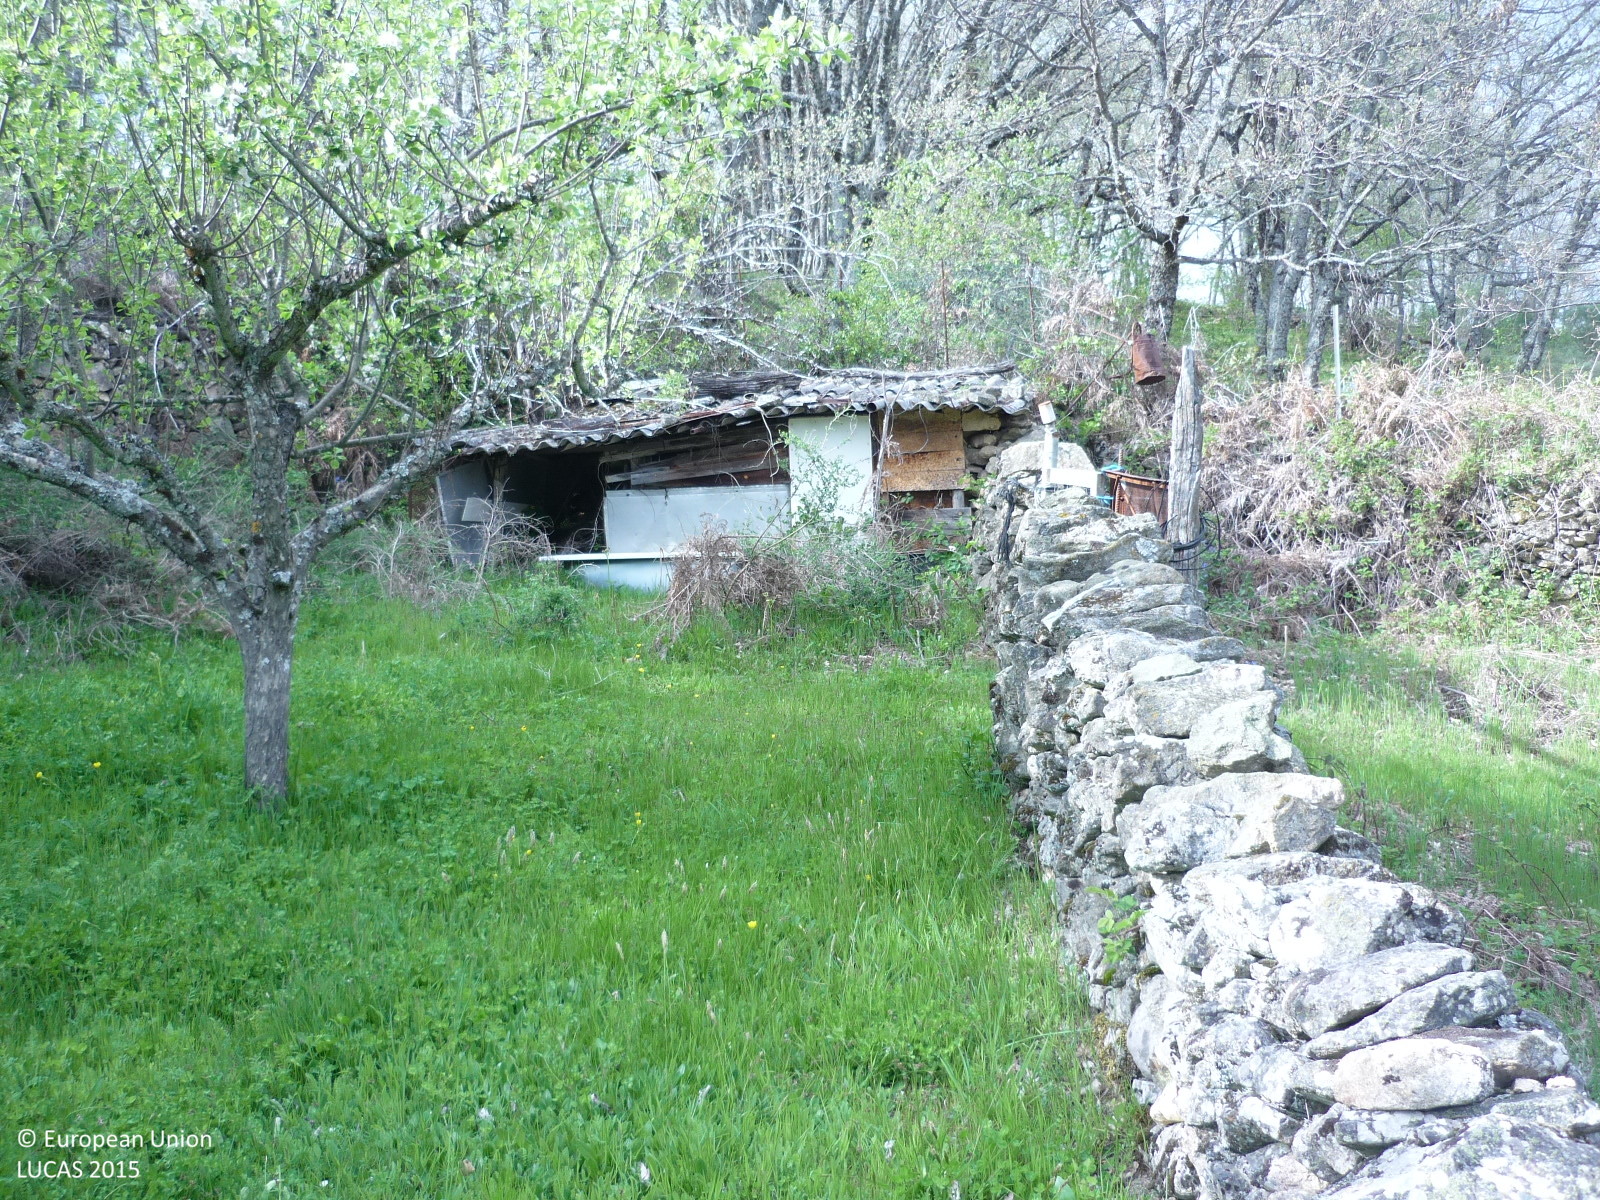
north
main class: Cropland
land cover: Apple fruit
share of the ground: 25 - 50 %
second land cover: Grassland without tree/shrub cover
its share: > 75 %
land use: Agriculture (excluding fallow land and kitchen gardens)
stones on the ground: < 10 %
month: May
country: ES
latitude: 41.0878
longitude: -3.6277
